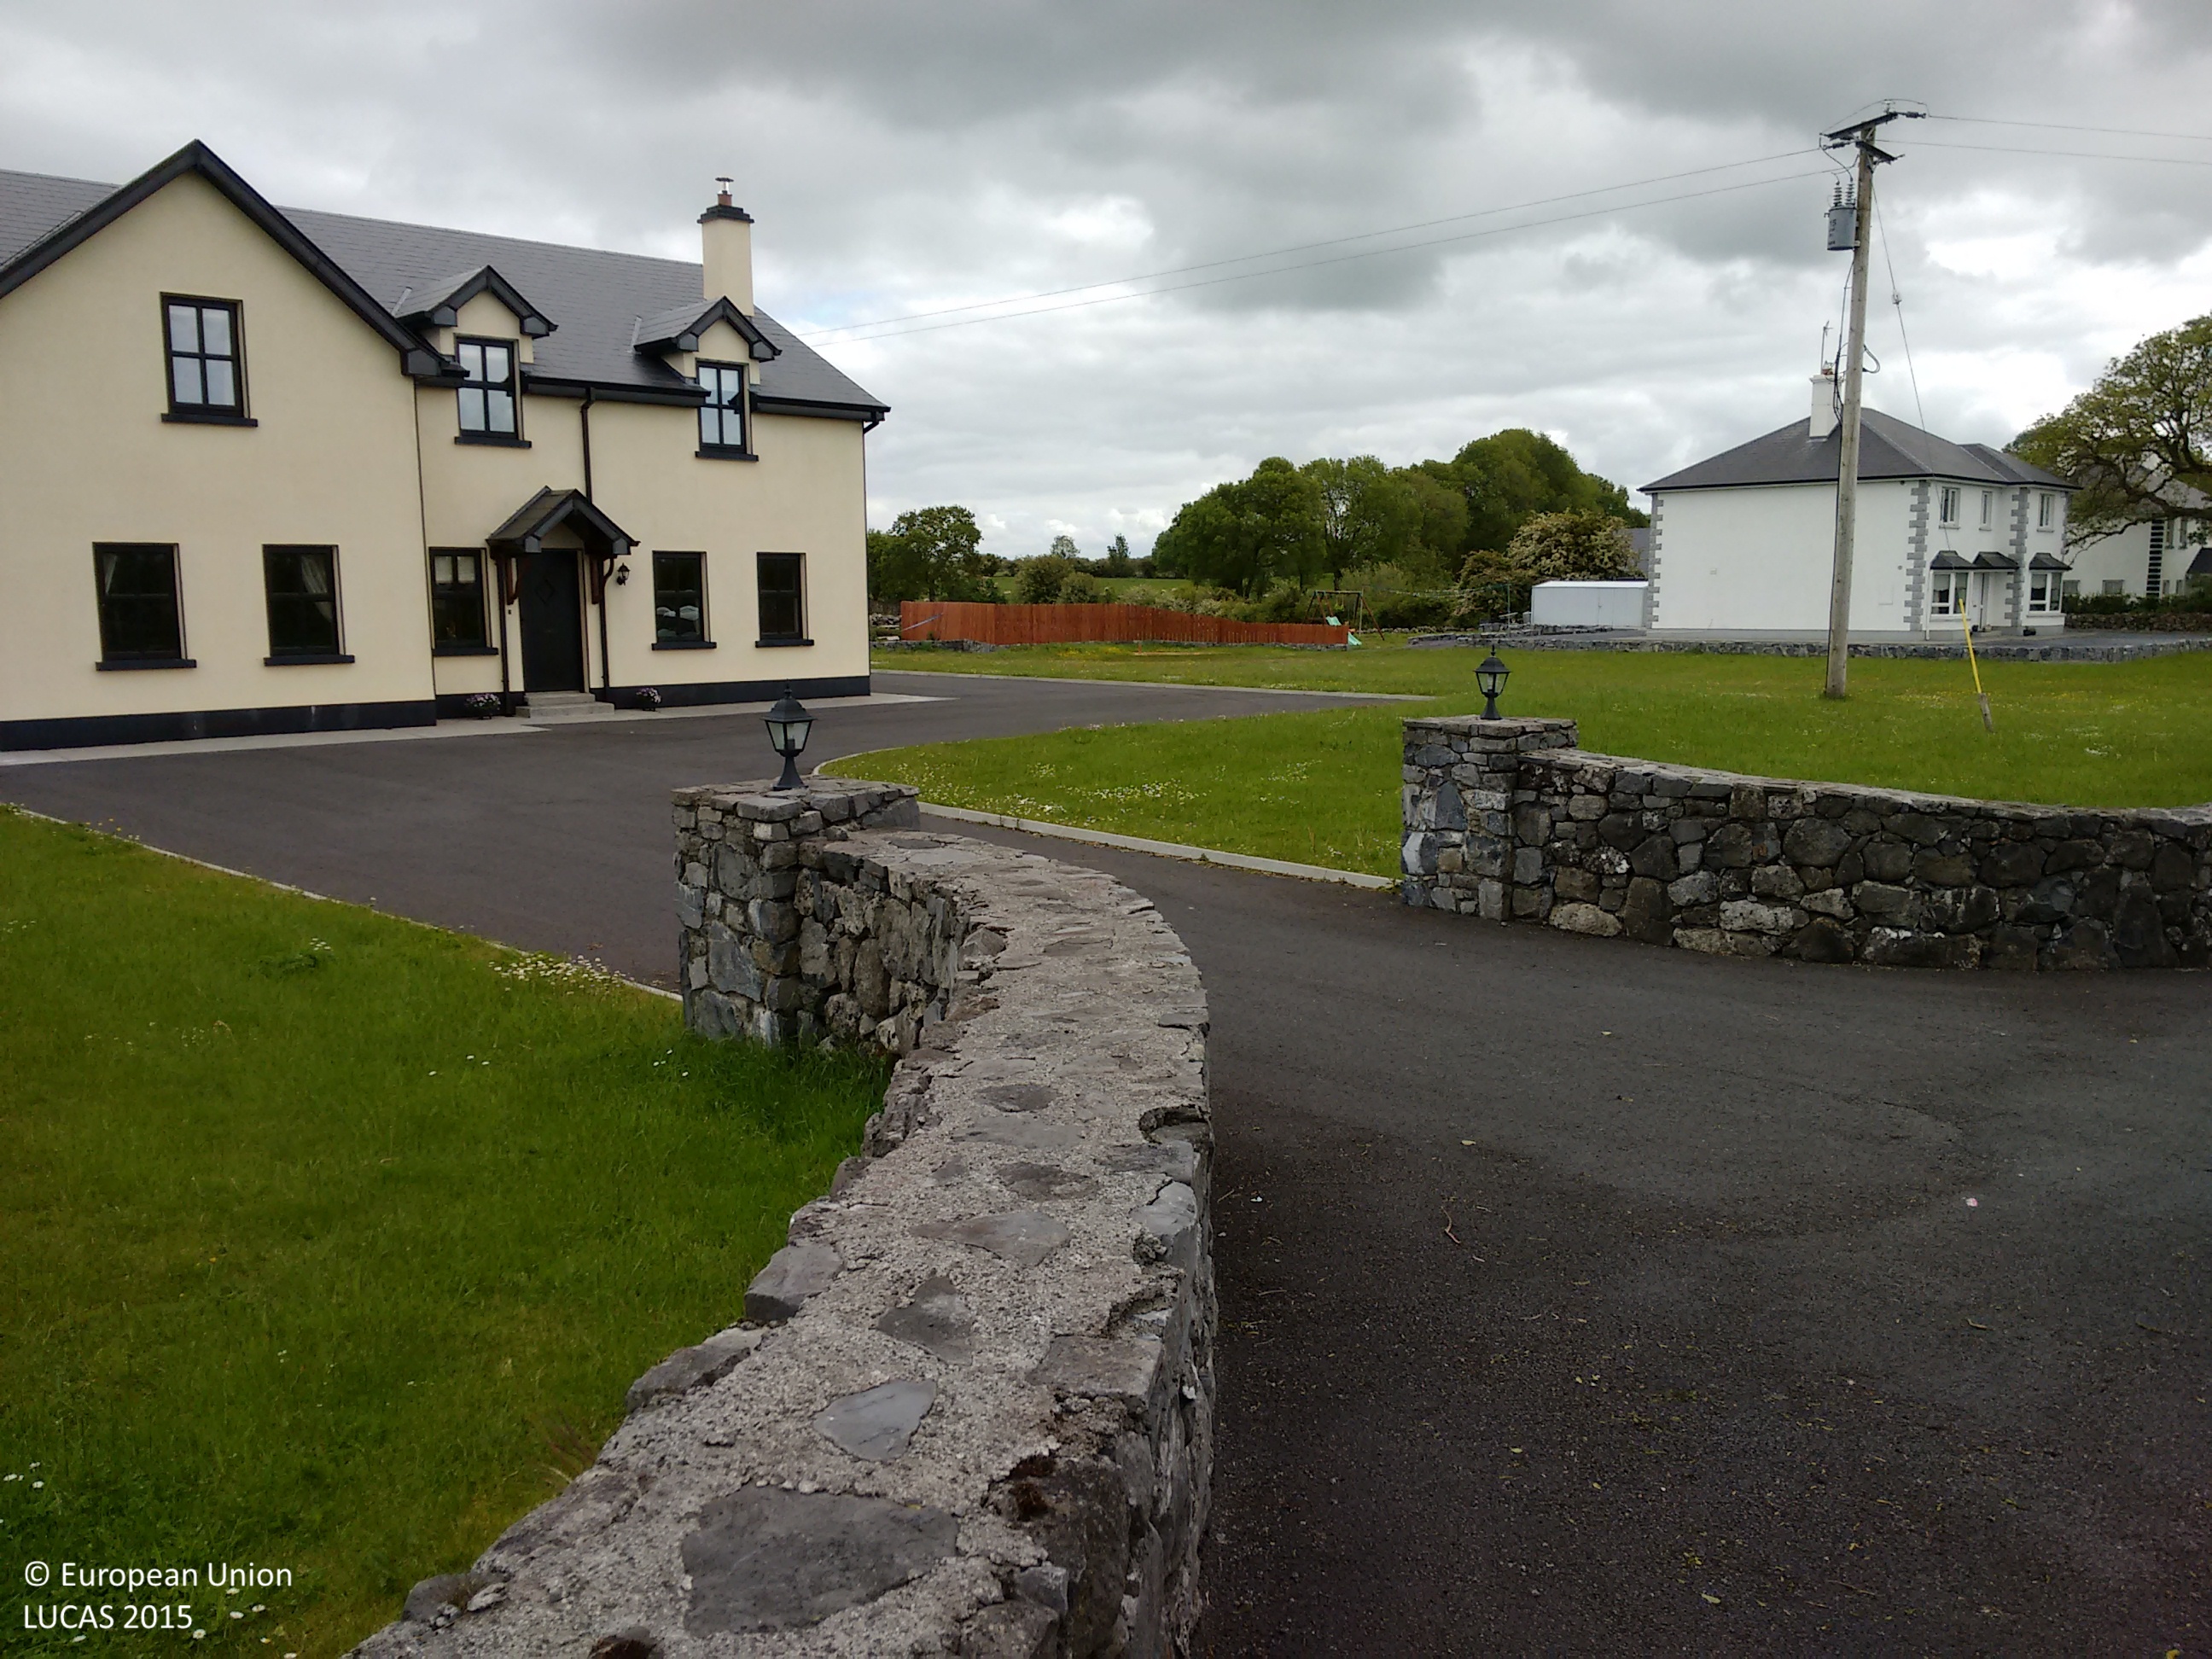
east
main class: Grassland
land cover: Grassland without tree/shrub cover
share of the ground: > 75 %
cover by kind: herbaceous plants 100 %
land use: Agriculture (excluding fallow land and kitchen gardens)
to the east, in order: Grassland without tree/shrub cover; Broadleaved woodland; Dry stone walls; Broadleaved woodland; Grassland without tree/shrub cover; Broadleaved woodland; Dry stone walls; Broadleaved woodland; Grassland without tree/shrub cover; Abandoned hedges; Dry stone walls; Abandoned hedges; Grassland without tree/shrub cover
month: June
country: IE
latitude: 53.4594
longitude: -9.0560
